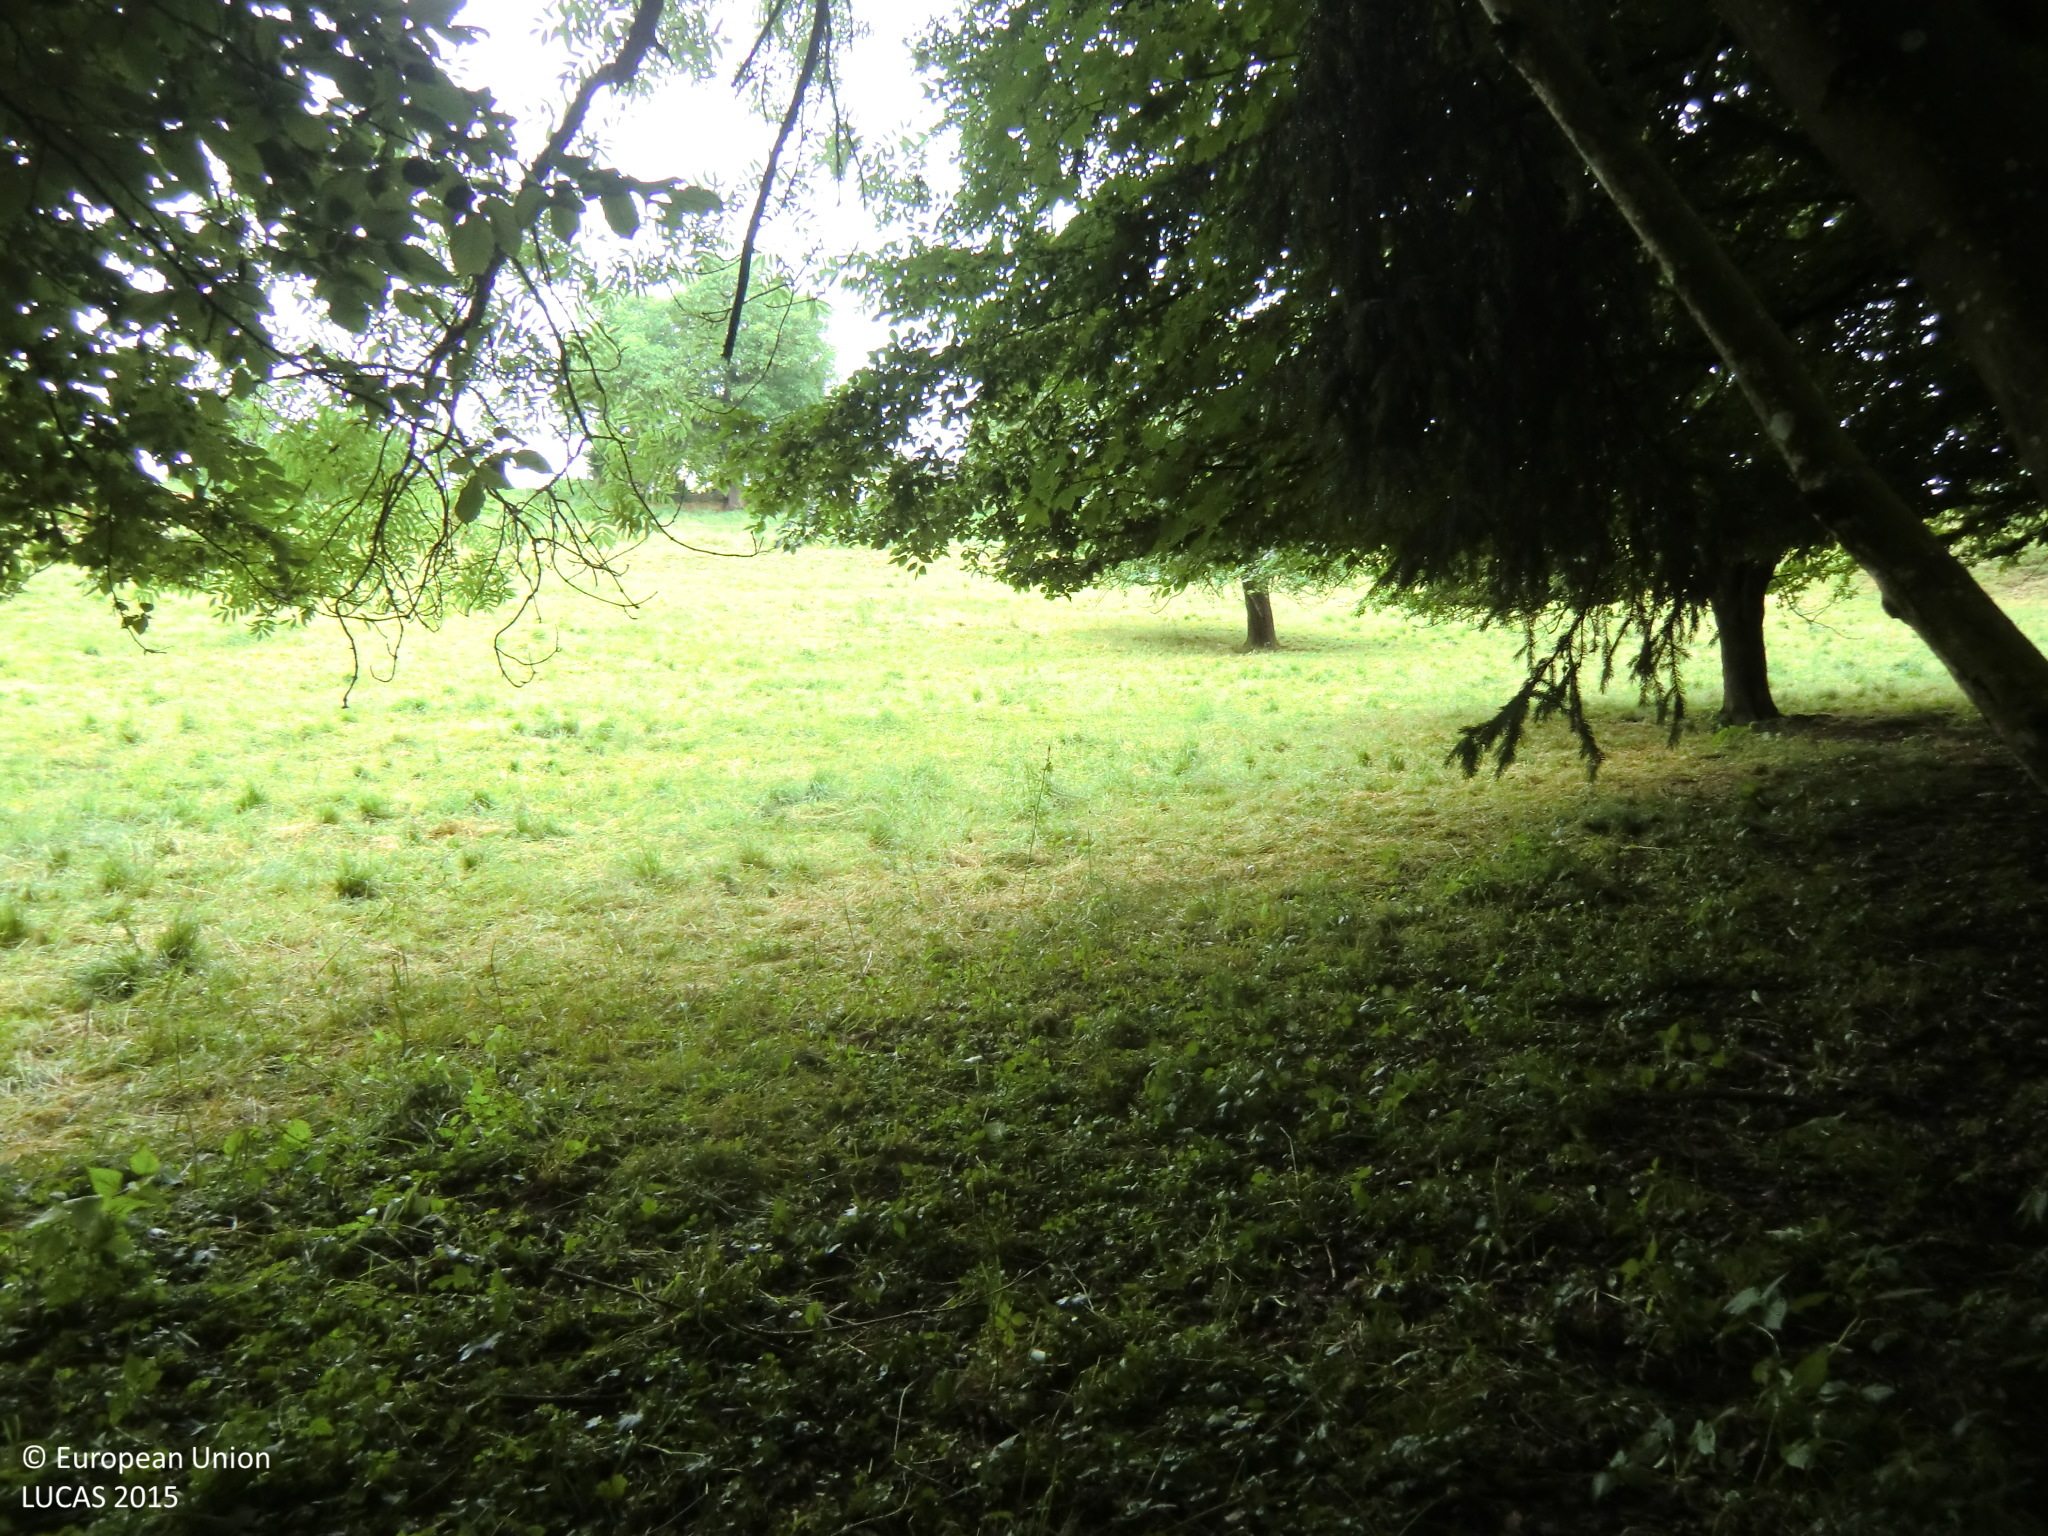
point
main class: Grassland
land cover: Grassland with sparse tree/shrub cover
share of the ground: > 75 %
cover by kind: herbaceous plants 95 %, broadleaved forest trees 5 %
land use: Agriculture (excluding fallow land and kitchen gardens)
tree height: > 5 m
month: June
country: AT
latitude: 48.2640
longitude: 14.7832
